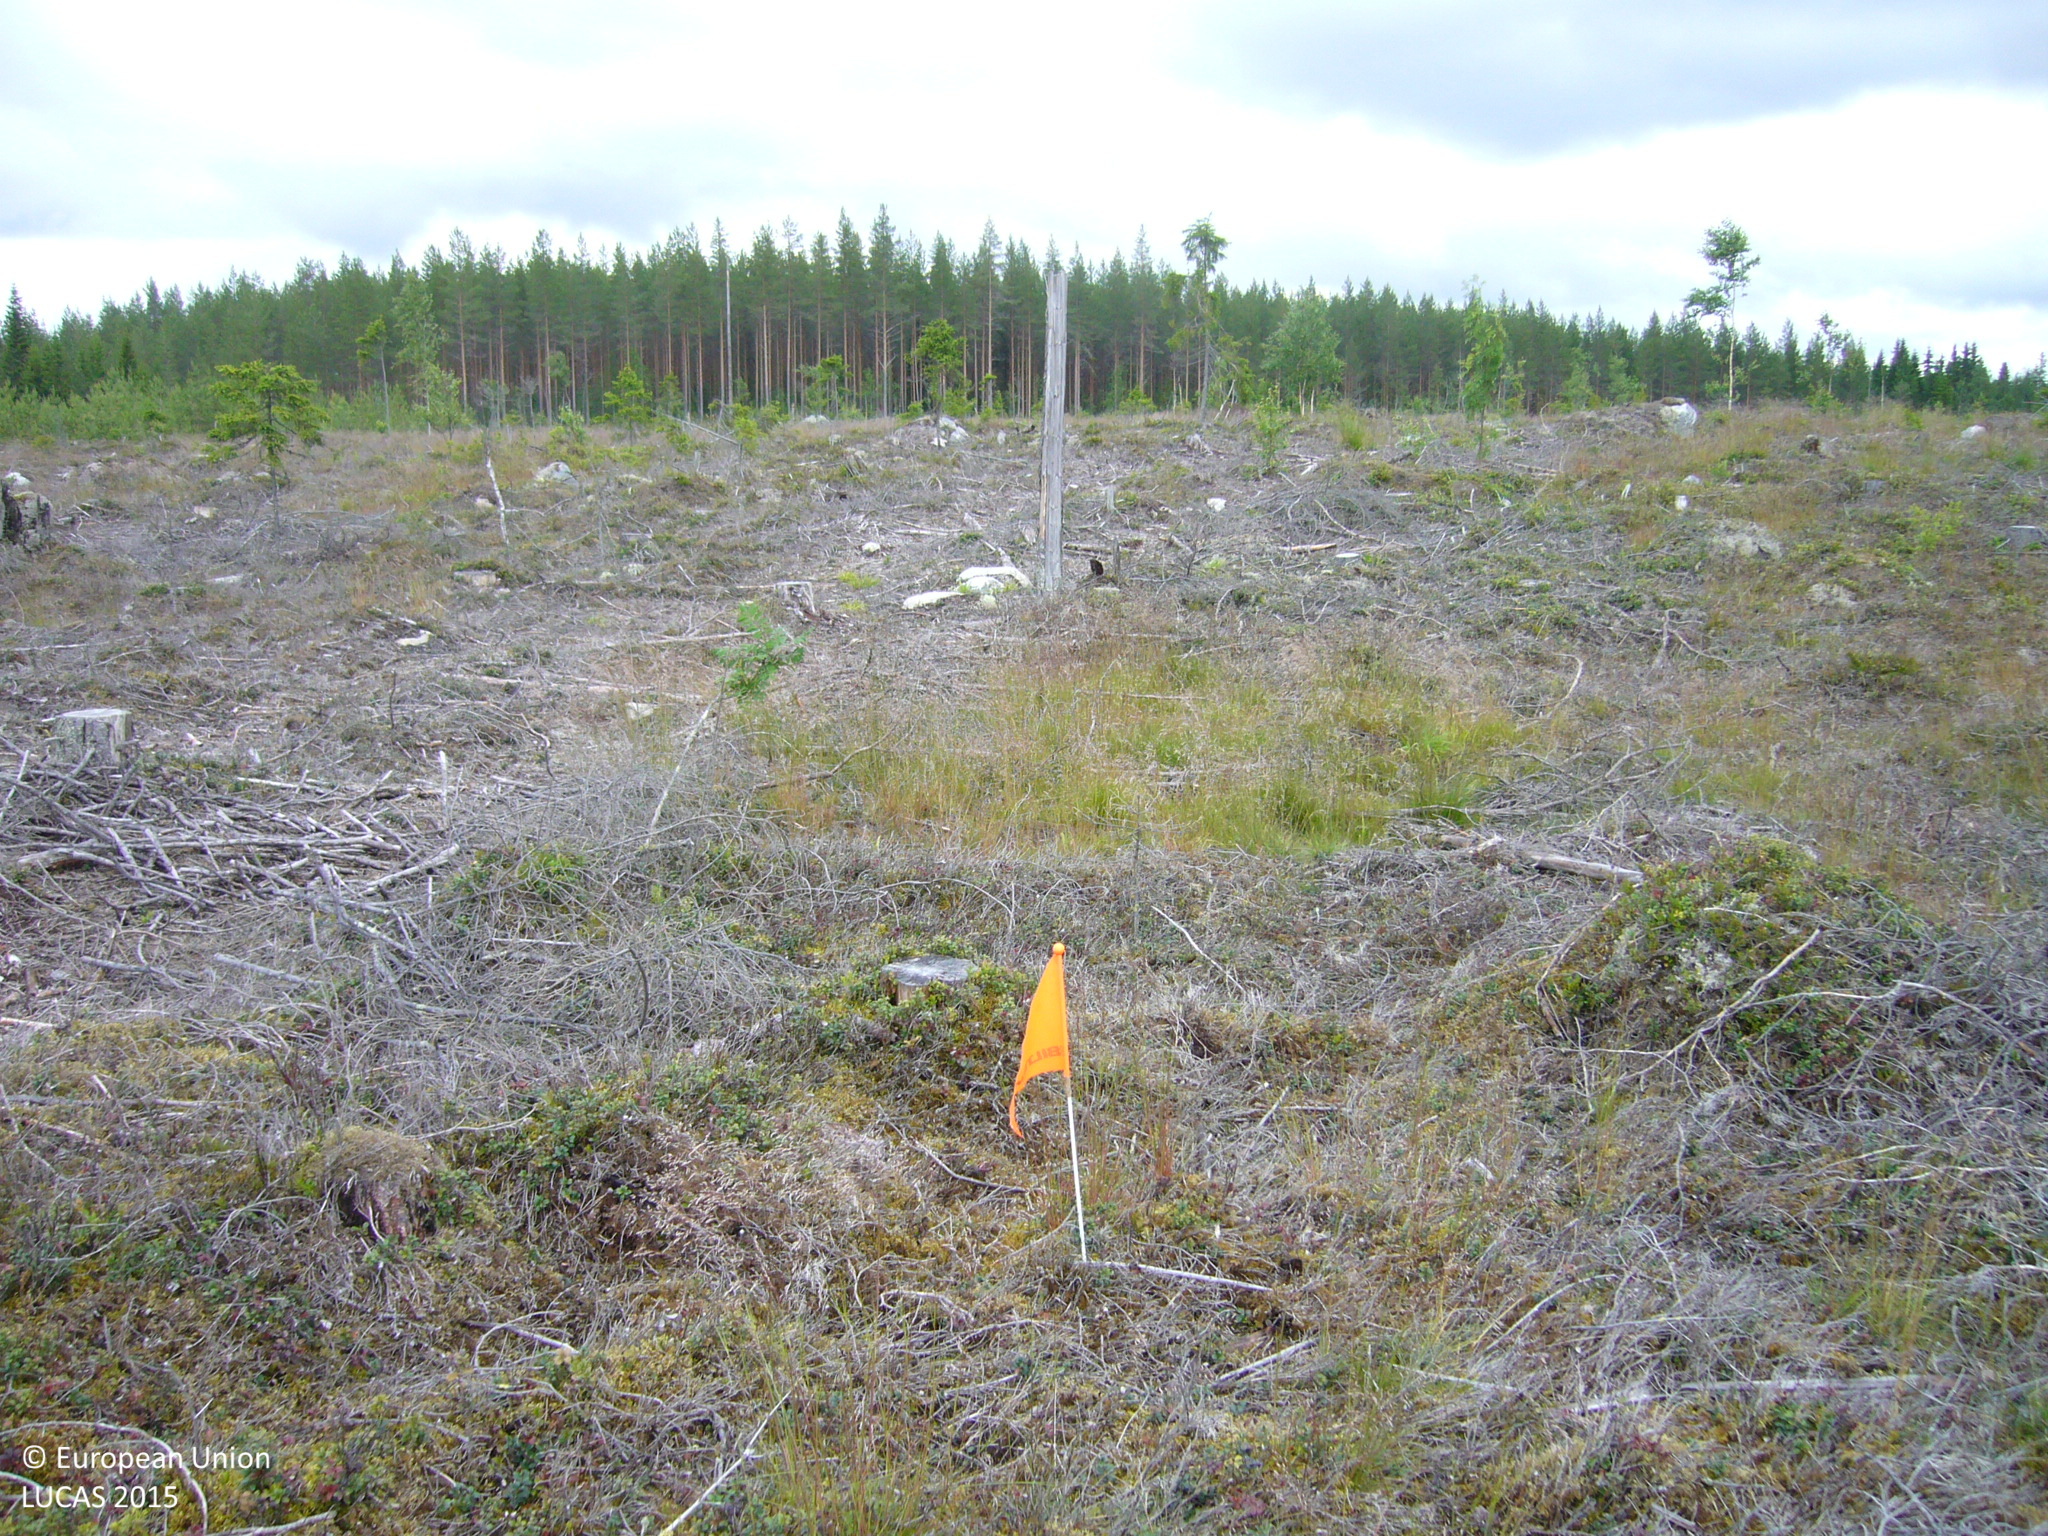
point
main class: Shrubland
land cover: Shrubland without tree cover
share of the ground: > 75 %
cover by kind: shrubs 60 %, lichens and mosses 20 %
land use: Forestry
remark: Clear cut
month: July
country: FI
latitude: 63.5751
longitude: 25.6734
